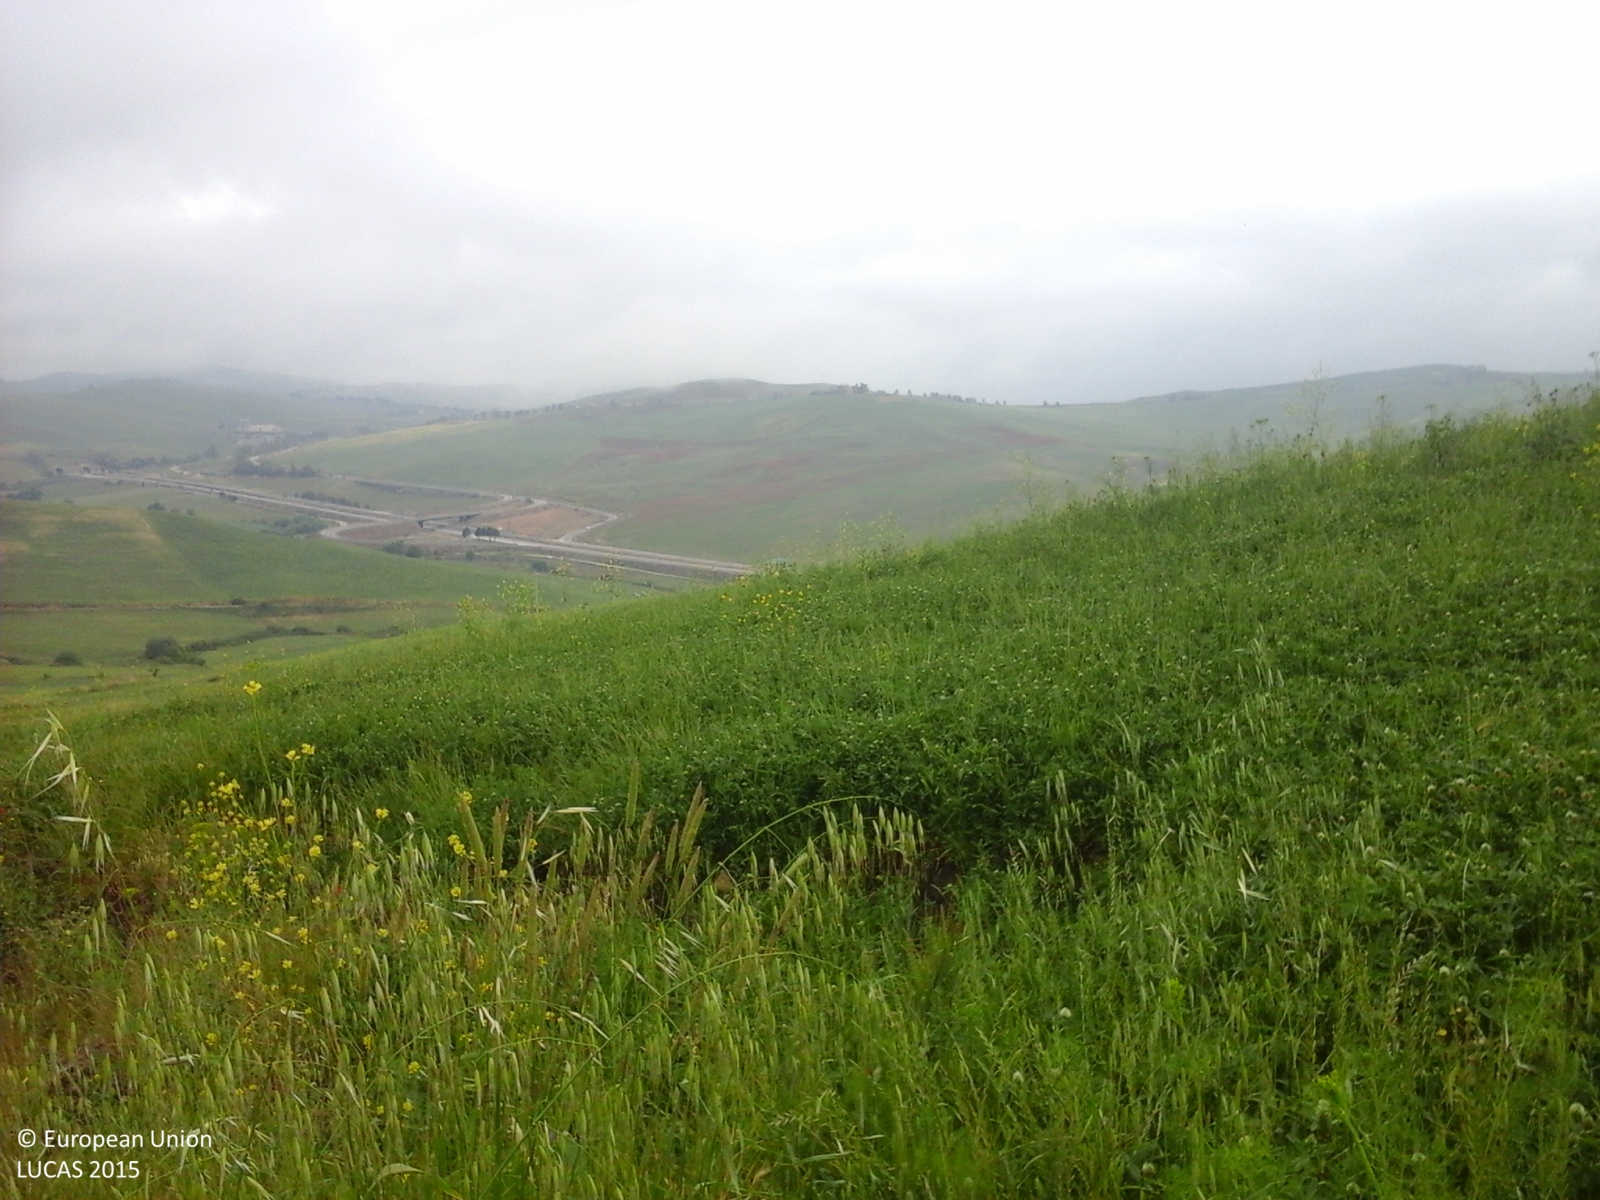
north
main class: Cropland
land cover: Durum wheat
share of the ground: > 75 %
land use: Agriculture (excluding fallow land and kitchen gardens)
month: May
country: IT
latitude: 37.7371
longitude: 13.9769
